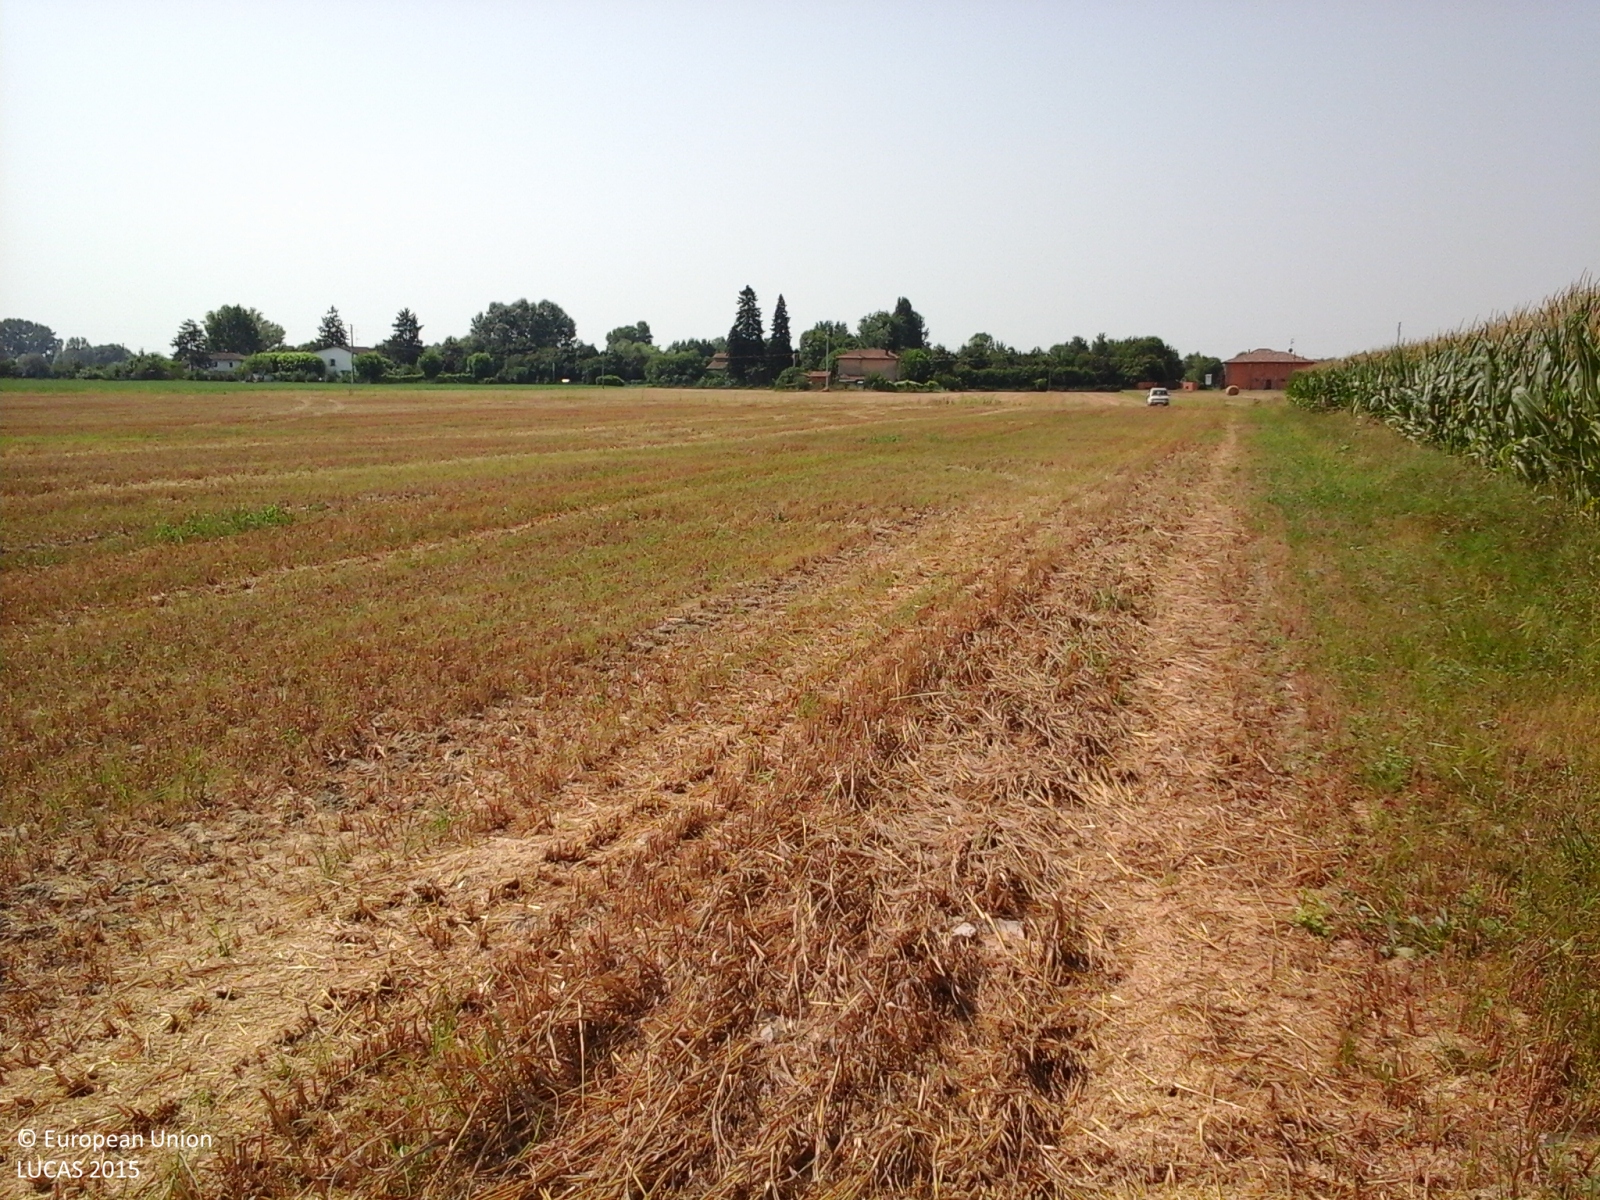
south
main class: Cropland
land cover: Maize
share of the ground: > 75 %
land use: Agriculture (excluding fallow land and kitchen gardens)
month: July
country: IT
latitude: 44.5900
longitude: 11.6467
